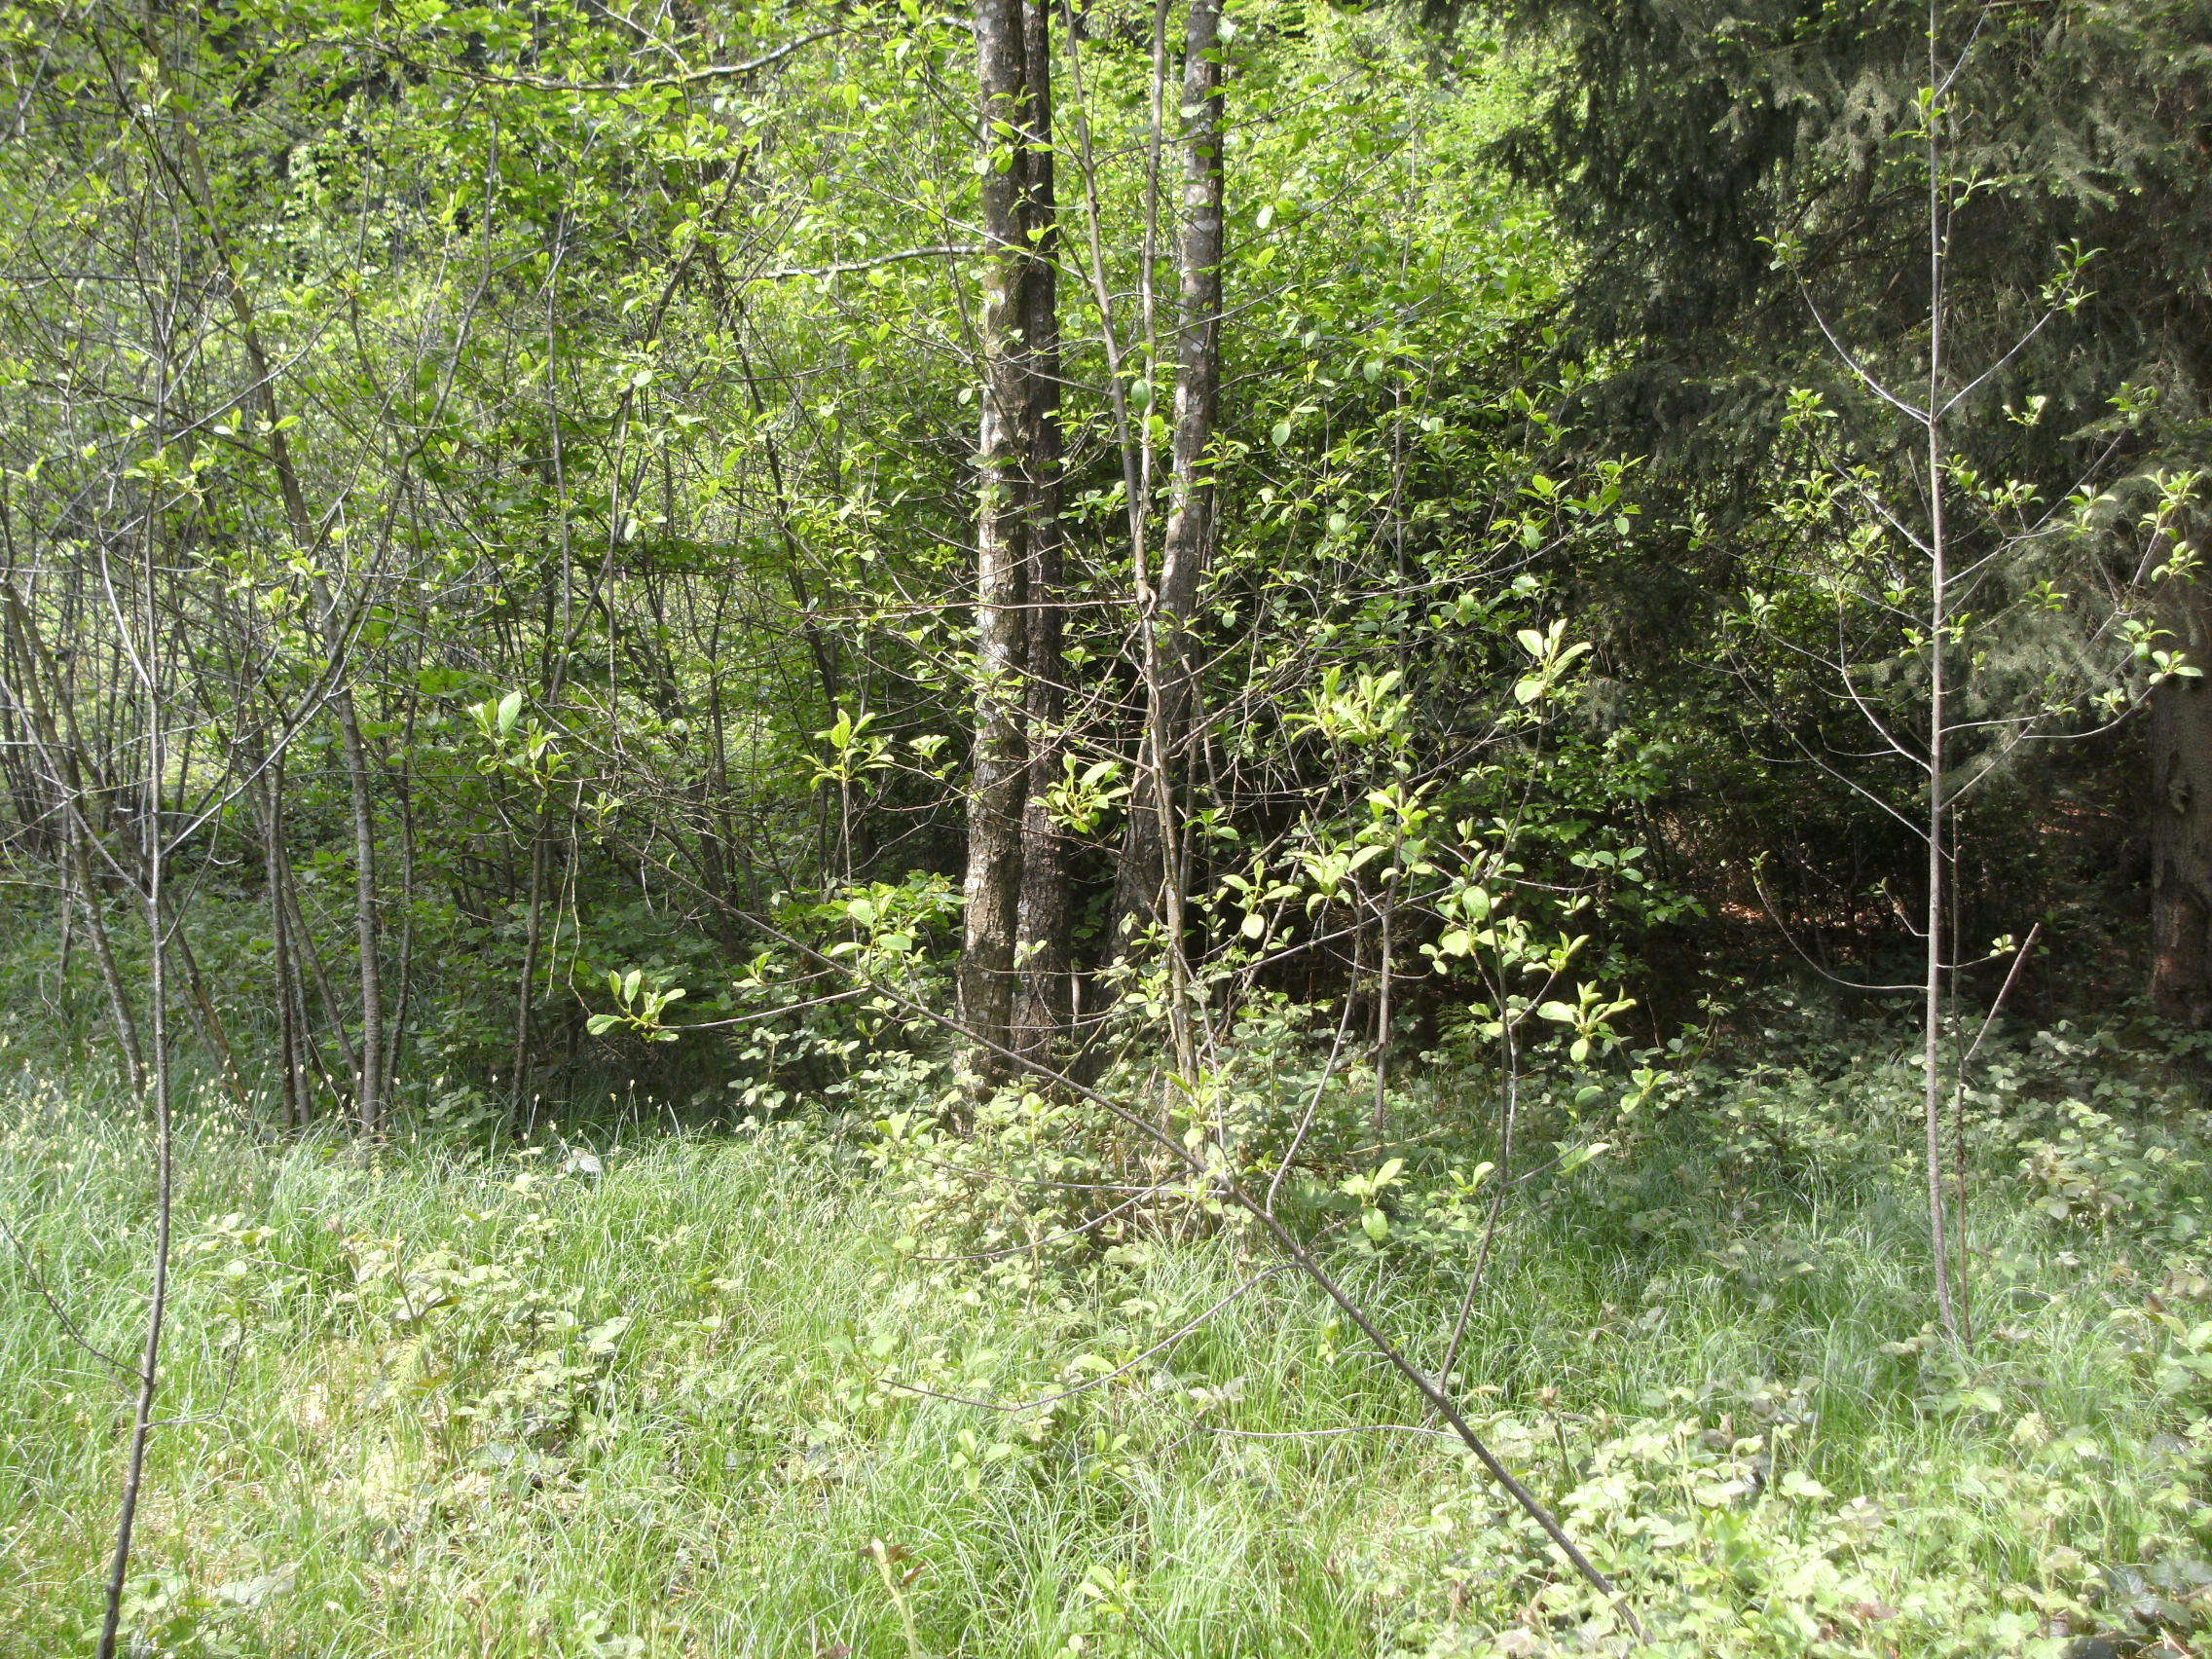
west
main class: Shrubland
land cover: Shrubland with sparse tree cover
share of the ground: > 75 %
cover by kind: shrubs 65 %, herbaceous plants 30 %, coniferous forest trees 5 %
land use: Forestry
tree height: > 5 m
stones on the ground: < 10 %
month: May
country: AT
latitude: 48.4671
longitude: 13.7190
